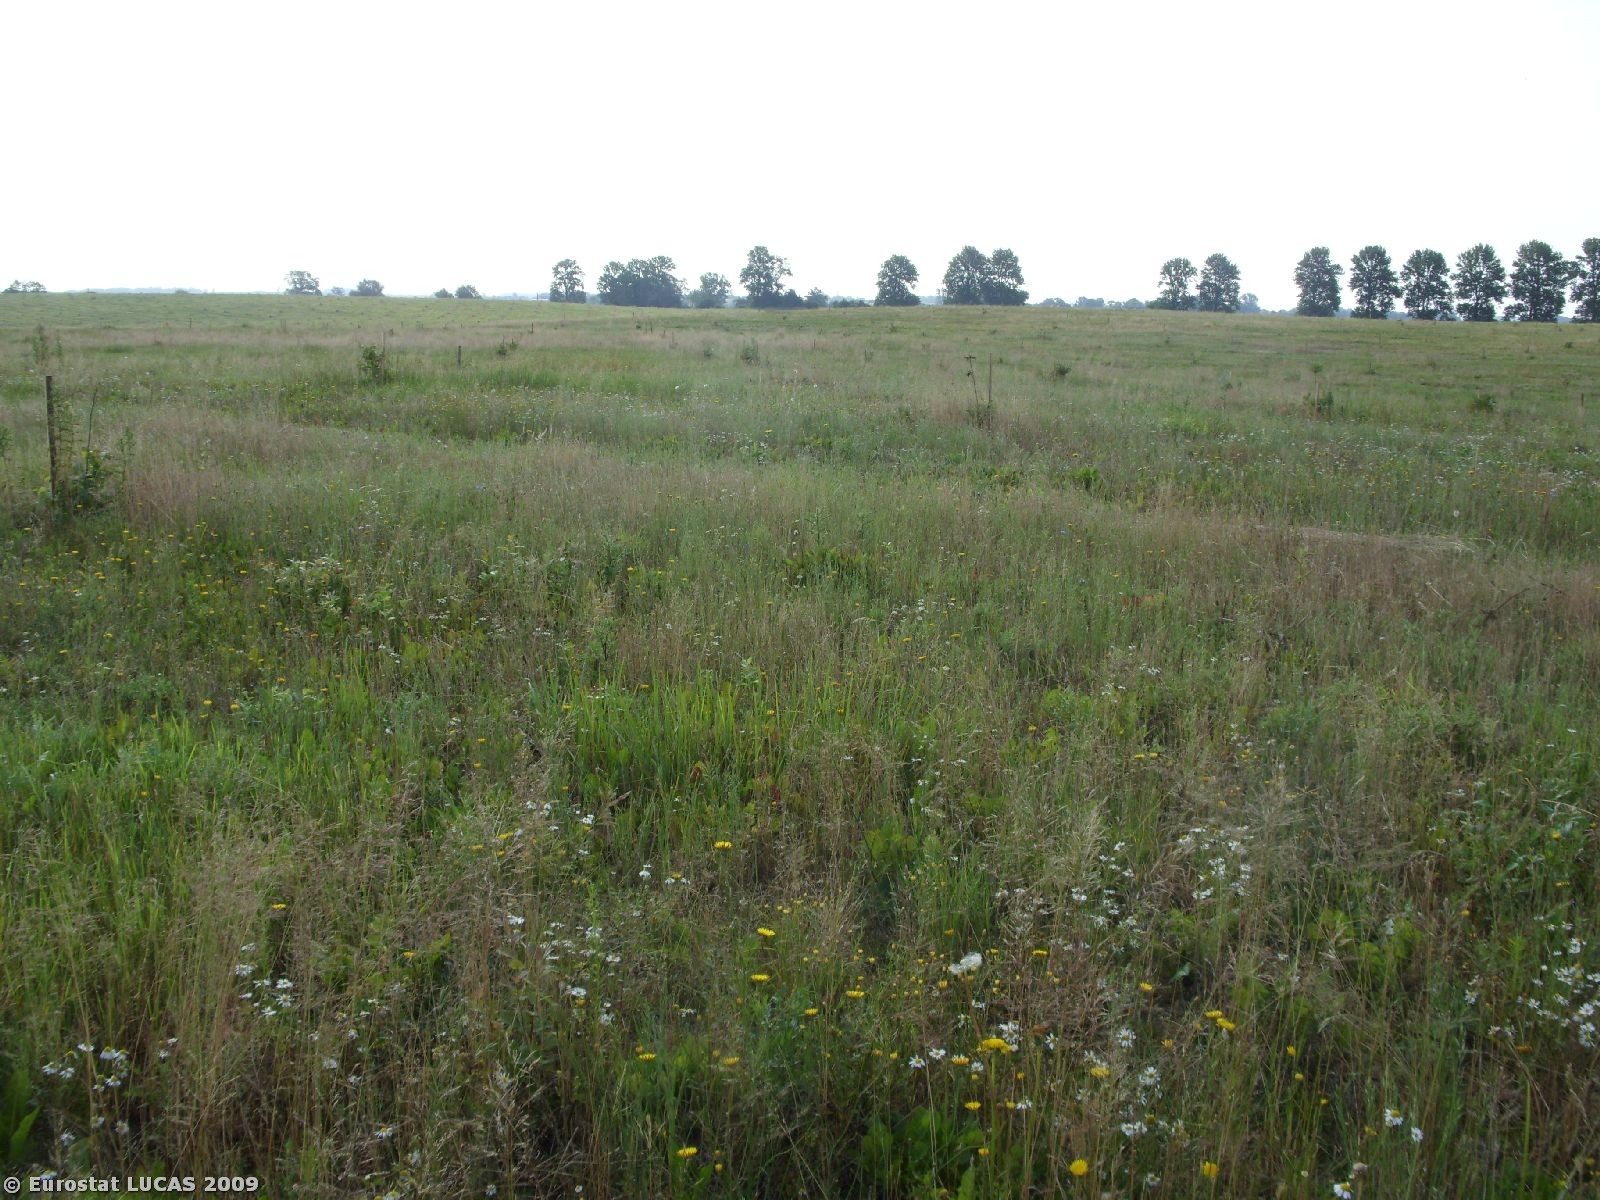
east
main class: Cropland
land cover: Nuts trees
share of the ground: < 10 %
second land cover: Grassland with sparse tree/shrub cover
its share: > 75 %
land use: Agriculture (excluding fallow land and kitchen gardens)
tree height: > 5 m
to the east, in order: Nuts trees; Grassland with sparse tree/shrub cover
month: July
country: PL
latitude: 54.1557
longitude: 15.5922
